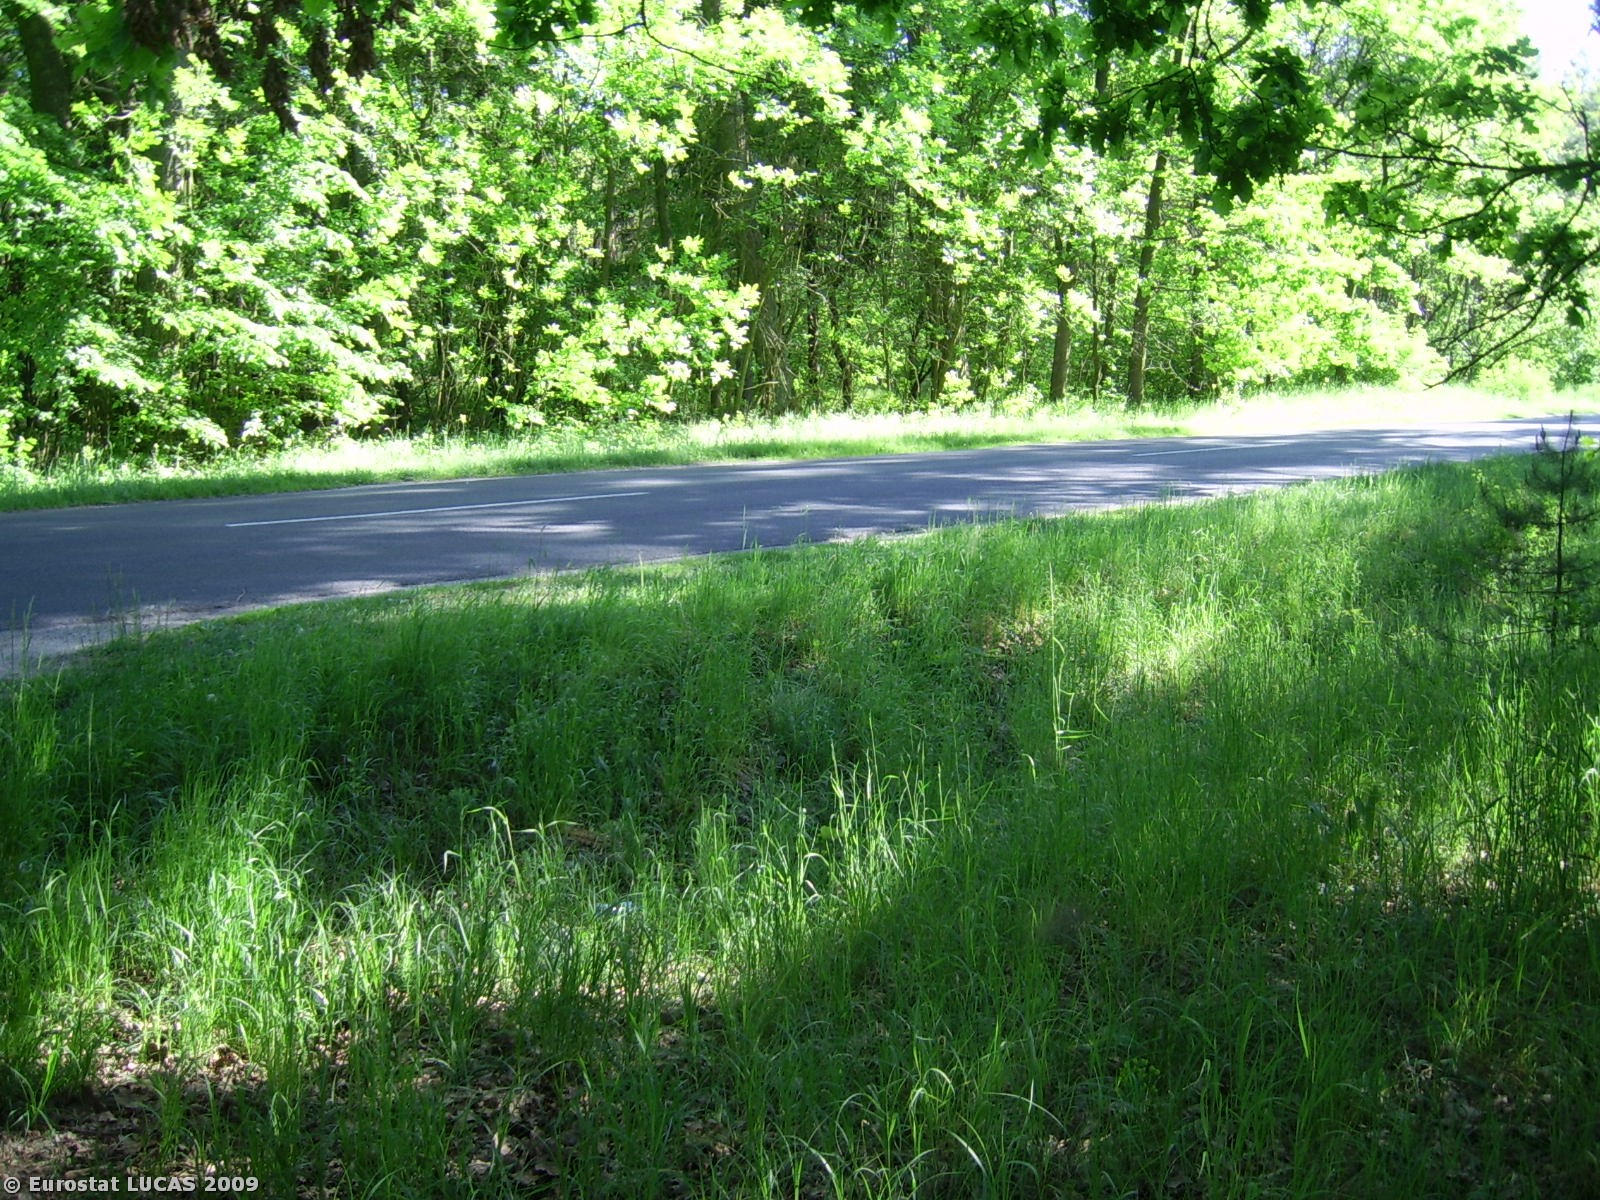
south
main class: Woodland
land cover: Coniferous woodland
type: hemiboreal forest and nemoral coniferous forest and mixed broadleaved-coniferous forest
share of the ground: > 75 %
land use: Forestry
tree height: > 5 m
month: May
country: PL
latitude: 51.7834
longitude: 16.8368
